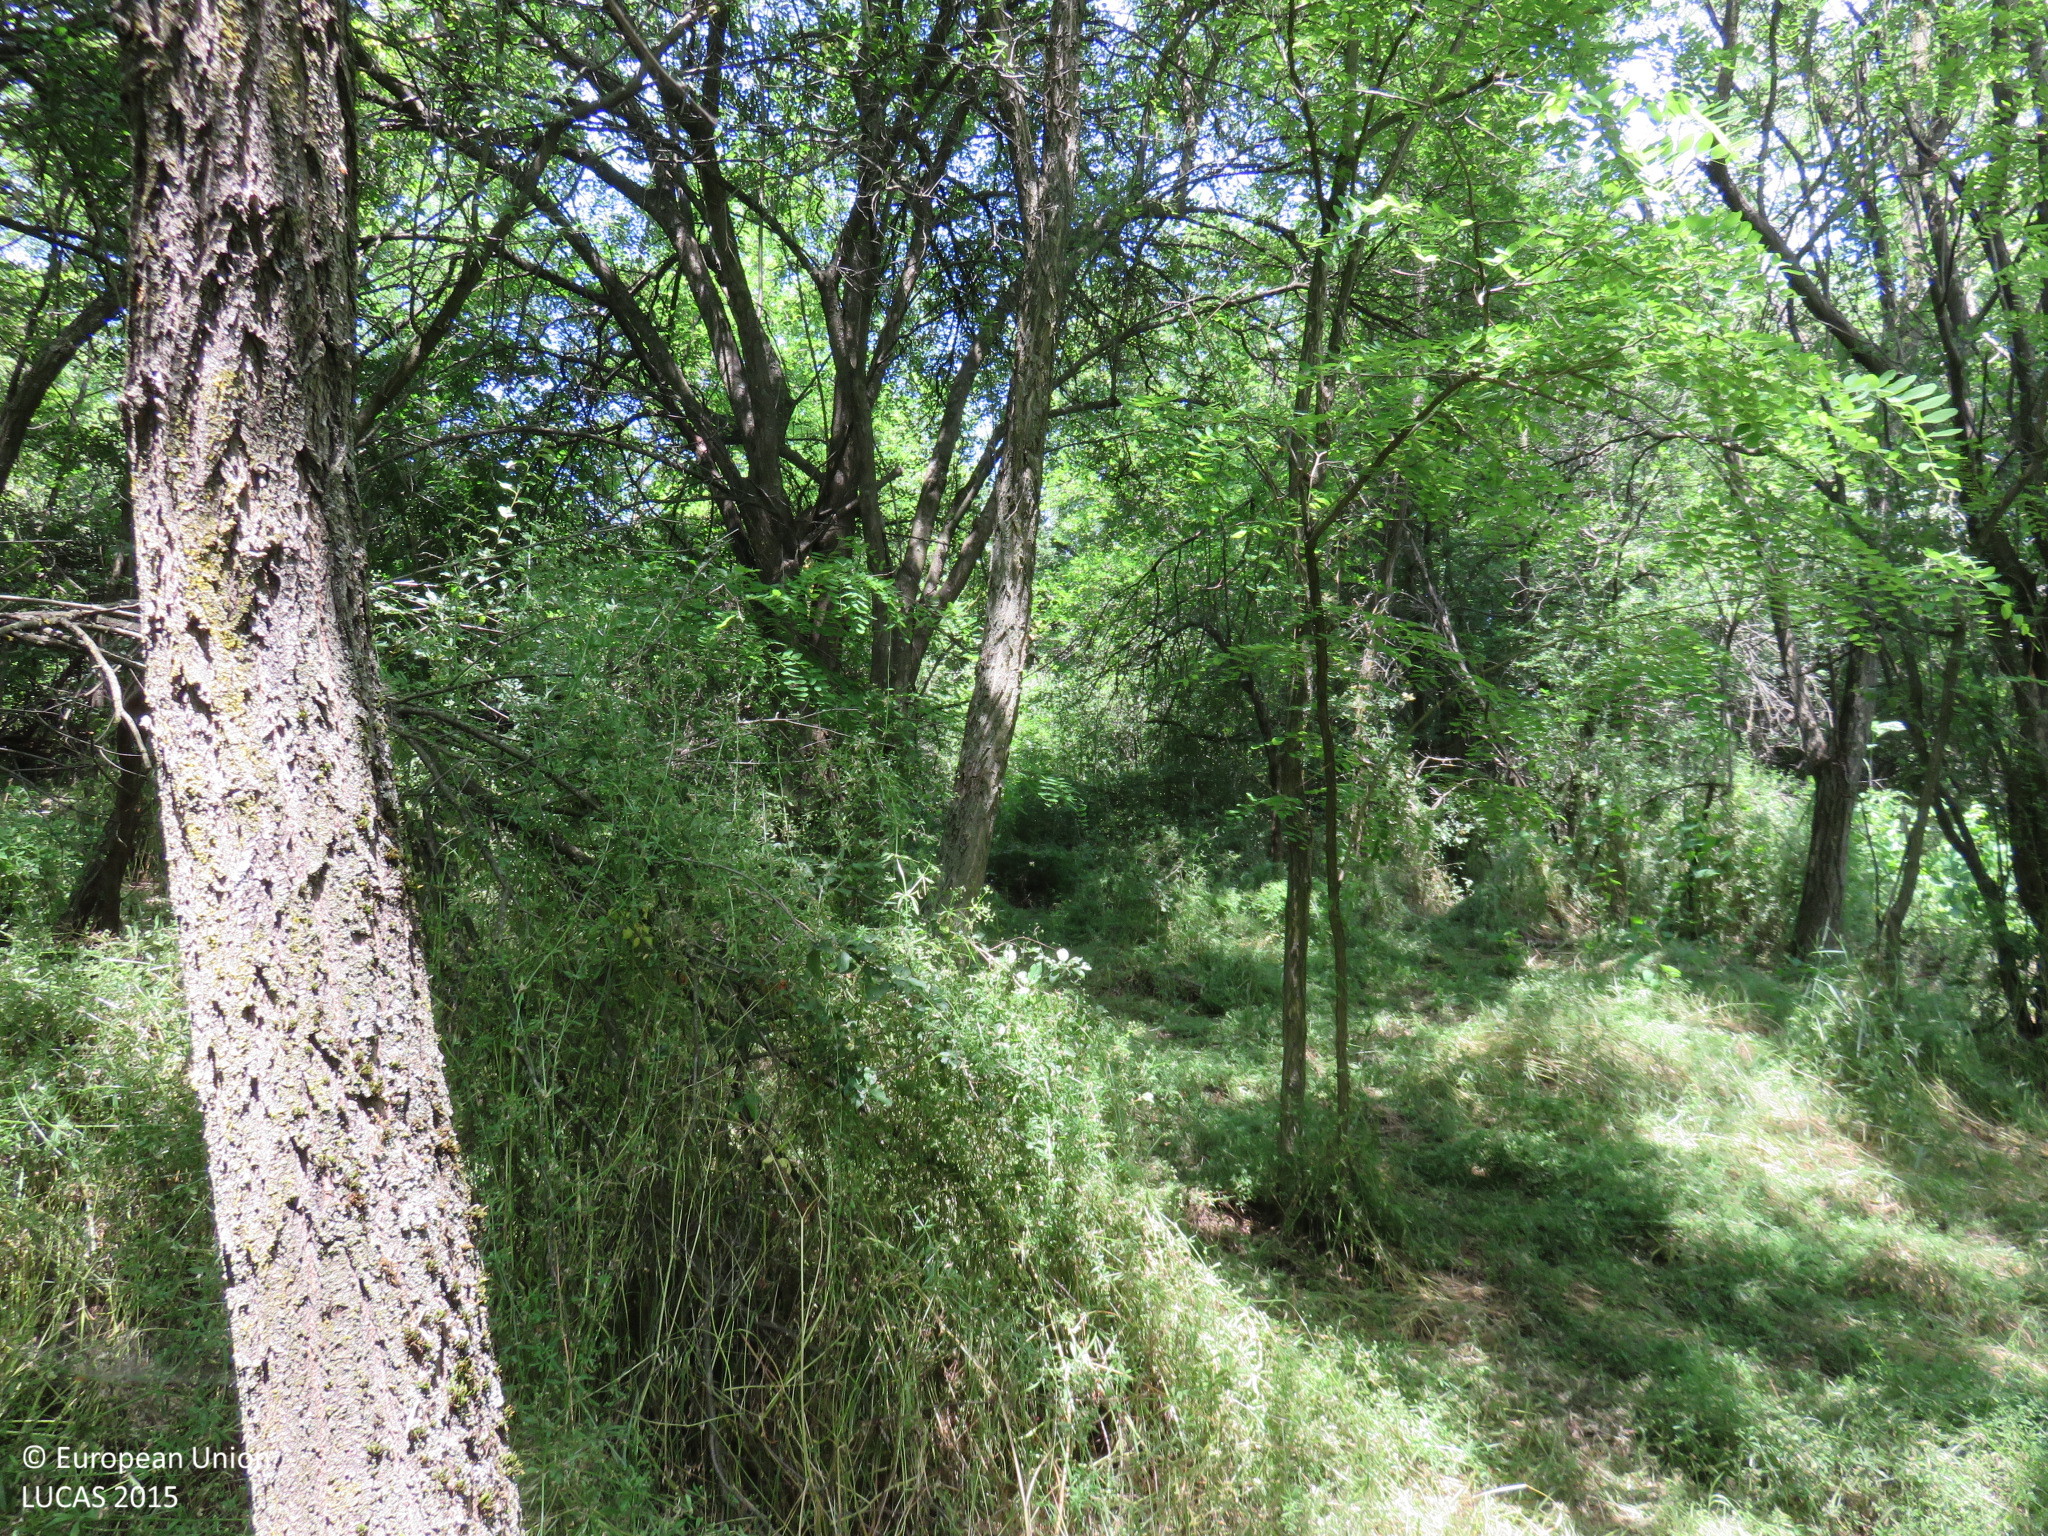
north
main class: Woodland
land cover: Broadleaved woodland
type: mesophytic deciduous forest
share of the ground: > 75 %
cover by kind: broadleaved forest trees 80 %, shrubs 10 %, herbaceous plants 10 %
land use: Forestry
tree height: < 5 m
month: June
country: BG
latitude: 43.2761
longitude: 24.4631
